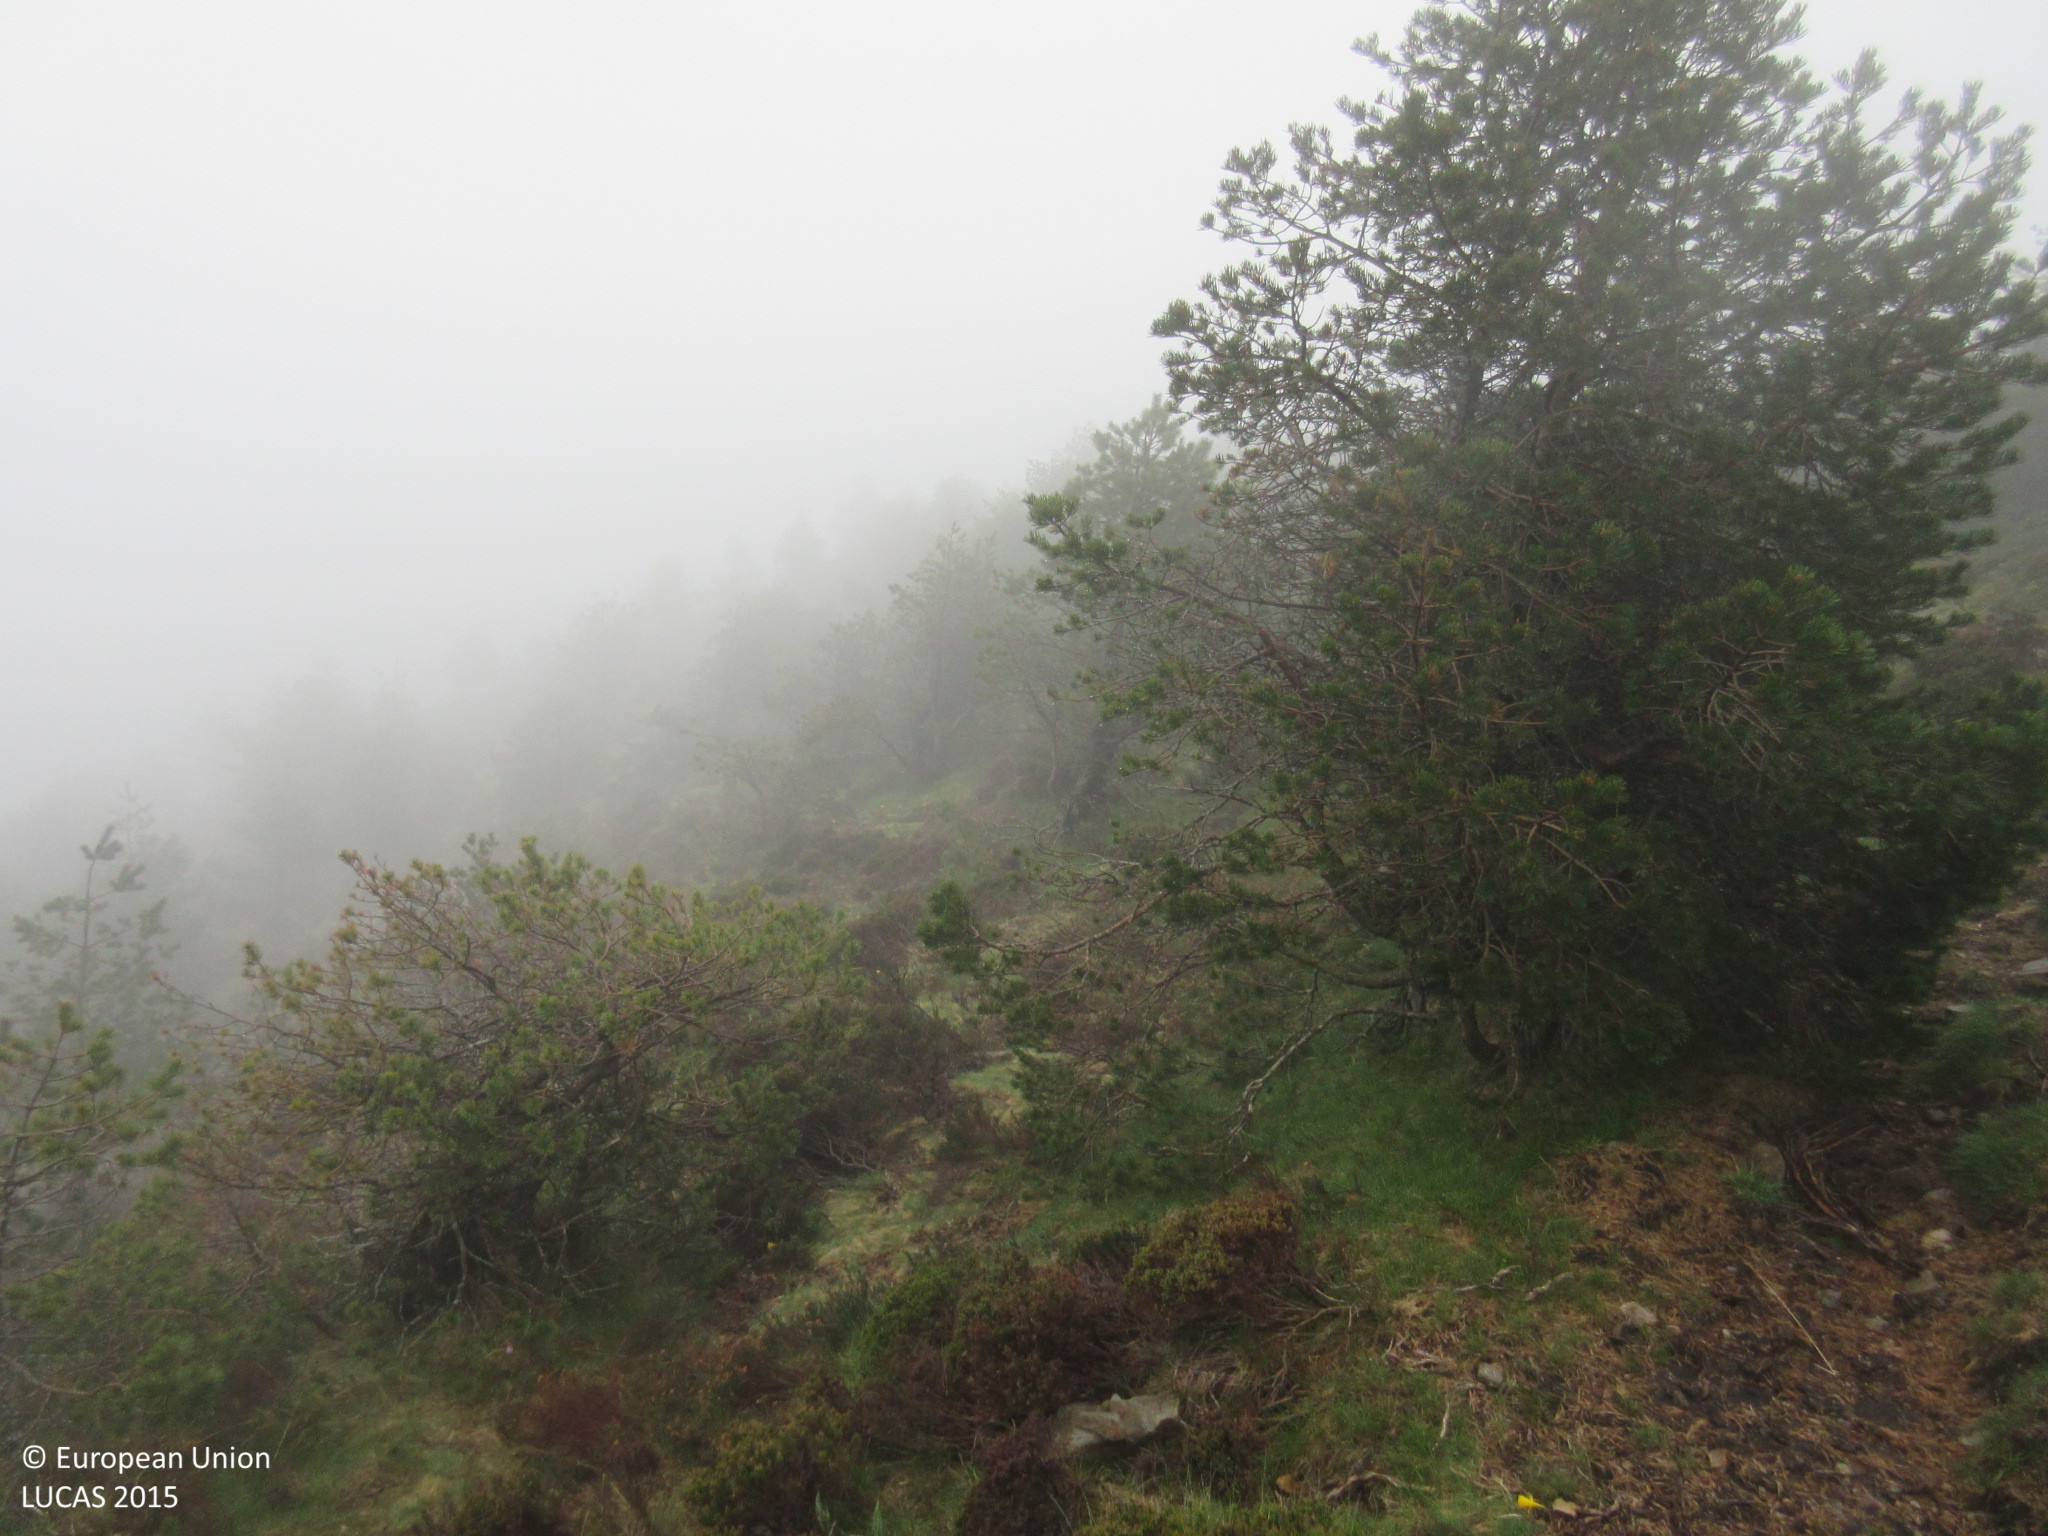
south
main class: Woodland
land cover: Pine dominated coniferous woodland
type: exotic forest
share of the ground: > 75 %
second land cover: Shrubland without tree cover
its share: > 75 %
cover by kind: coniferous forest trees 85 %, shrubs 15 %
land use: Forestry
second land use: Agriculture (excluding fallow land and kitchen gardens)
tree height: < 5 m
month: April
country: ES
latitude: 43.3695
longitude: -6.9348
